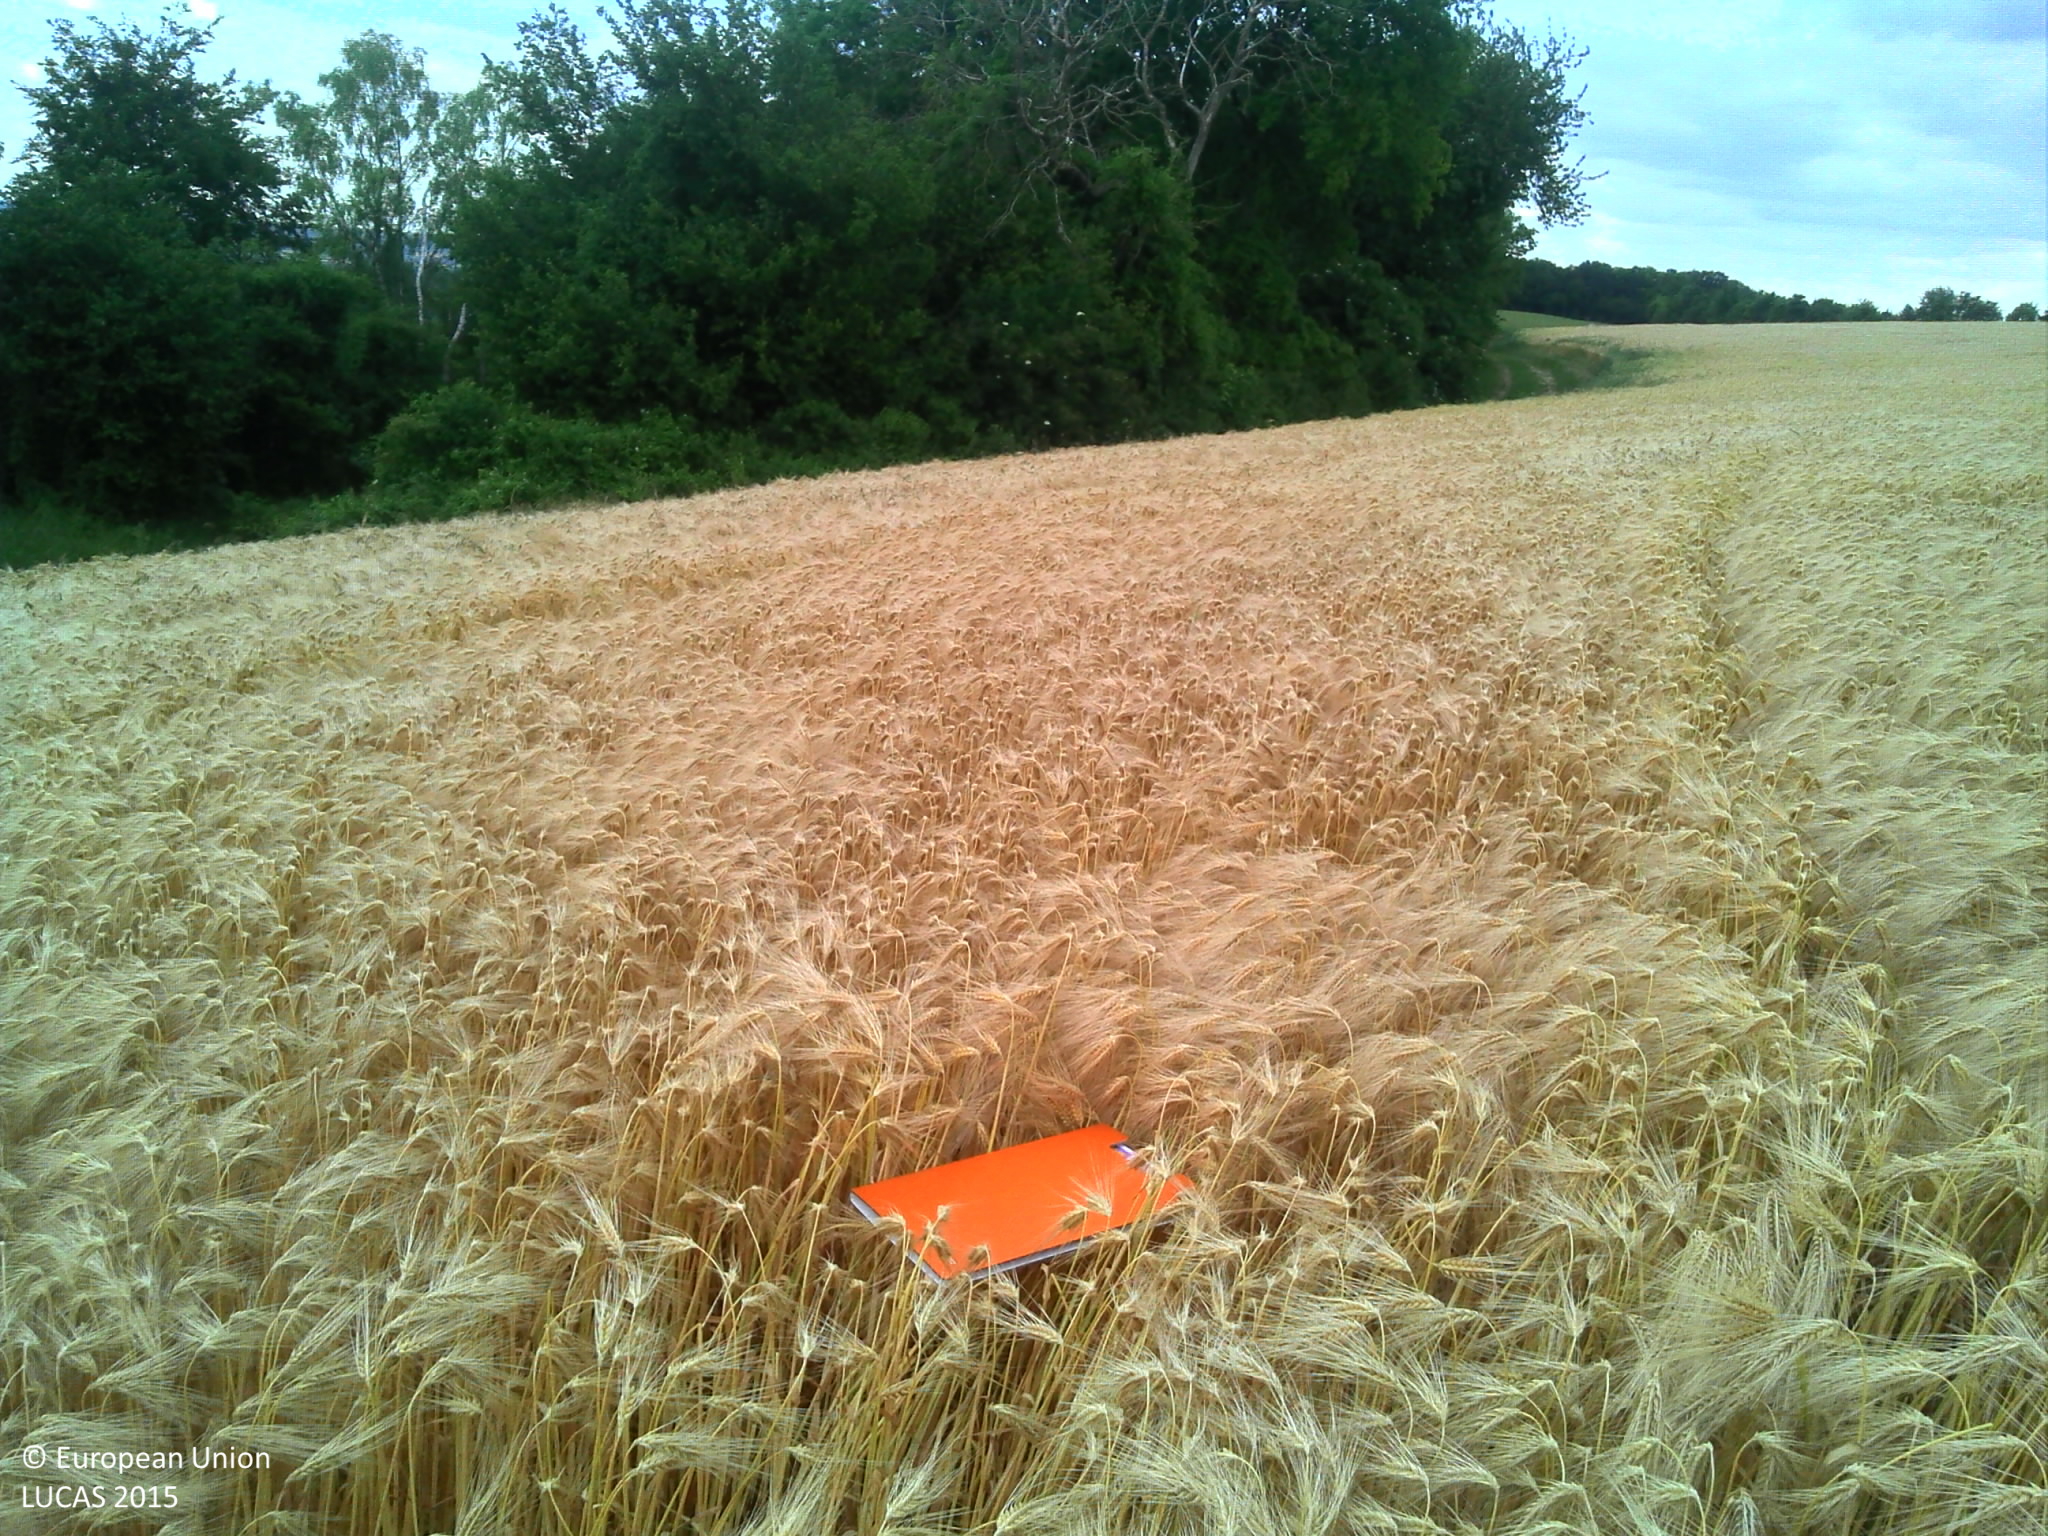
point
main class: Cropland
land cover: Barley
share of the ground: > 75 %
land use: Agriculture (excluding fallow land and kitchen gardens)
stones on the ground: < 10 %
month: June
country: FR
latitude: 49.4323
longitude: 3.6921
